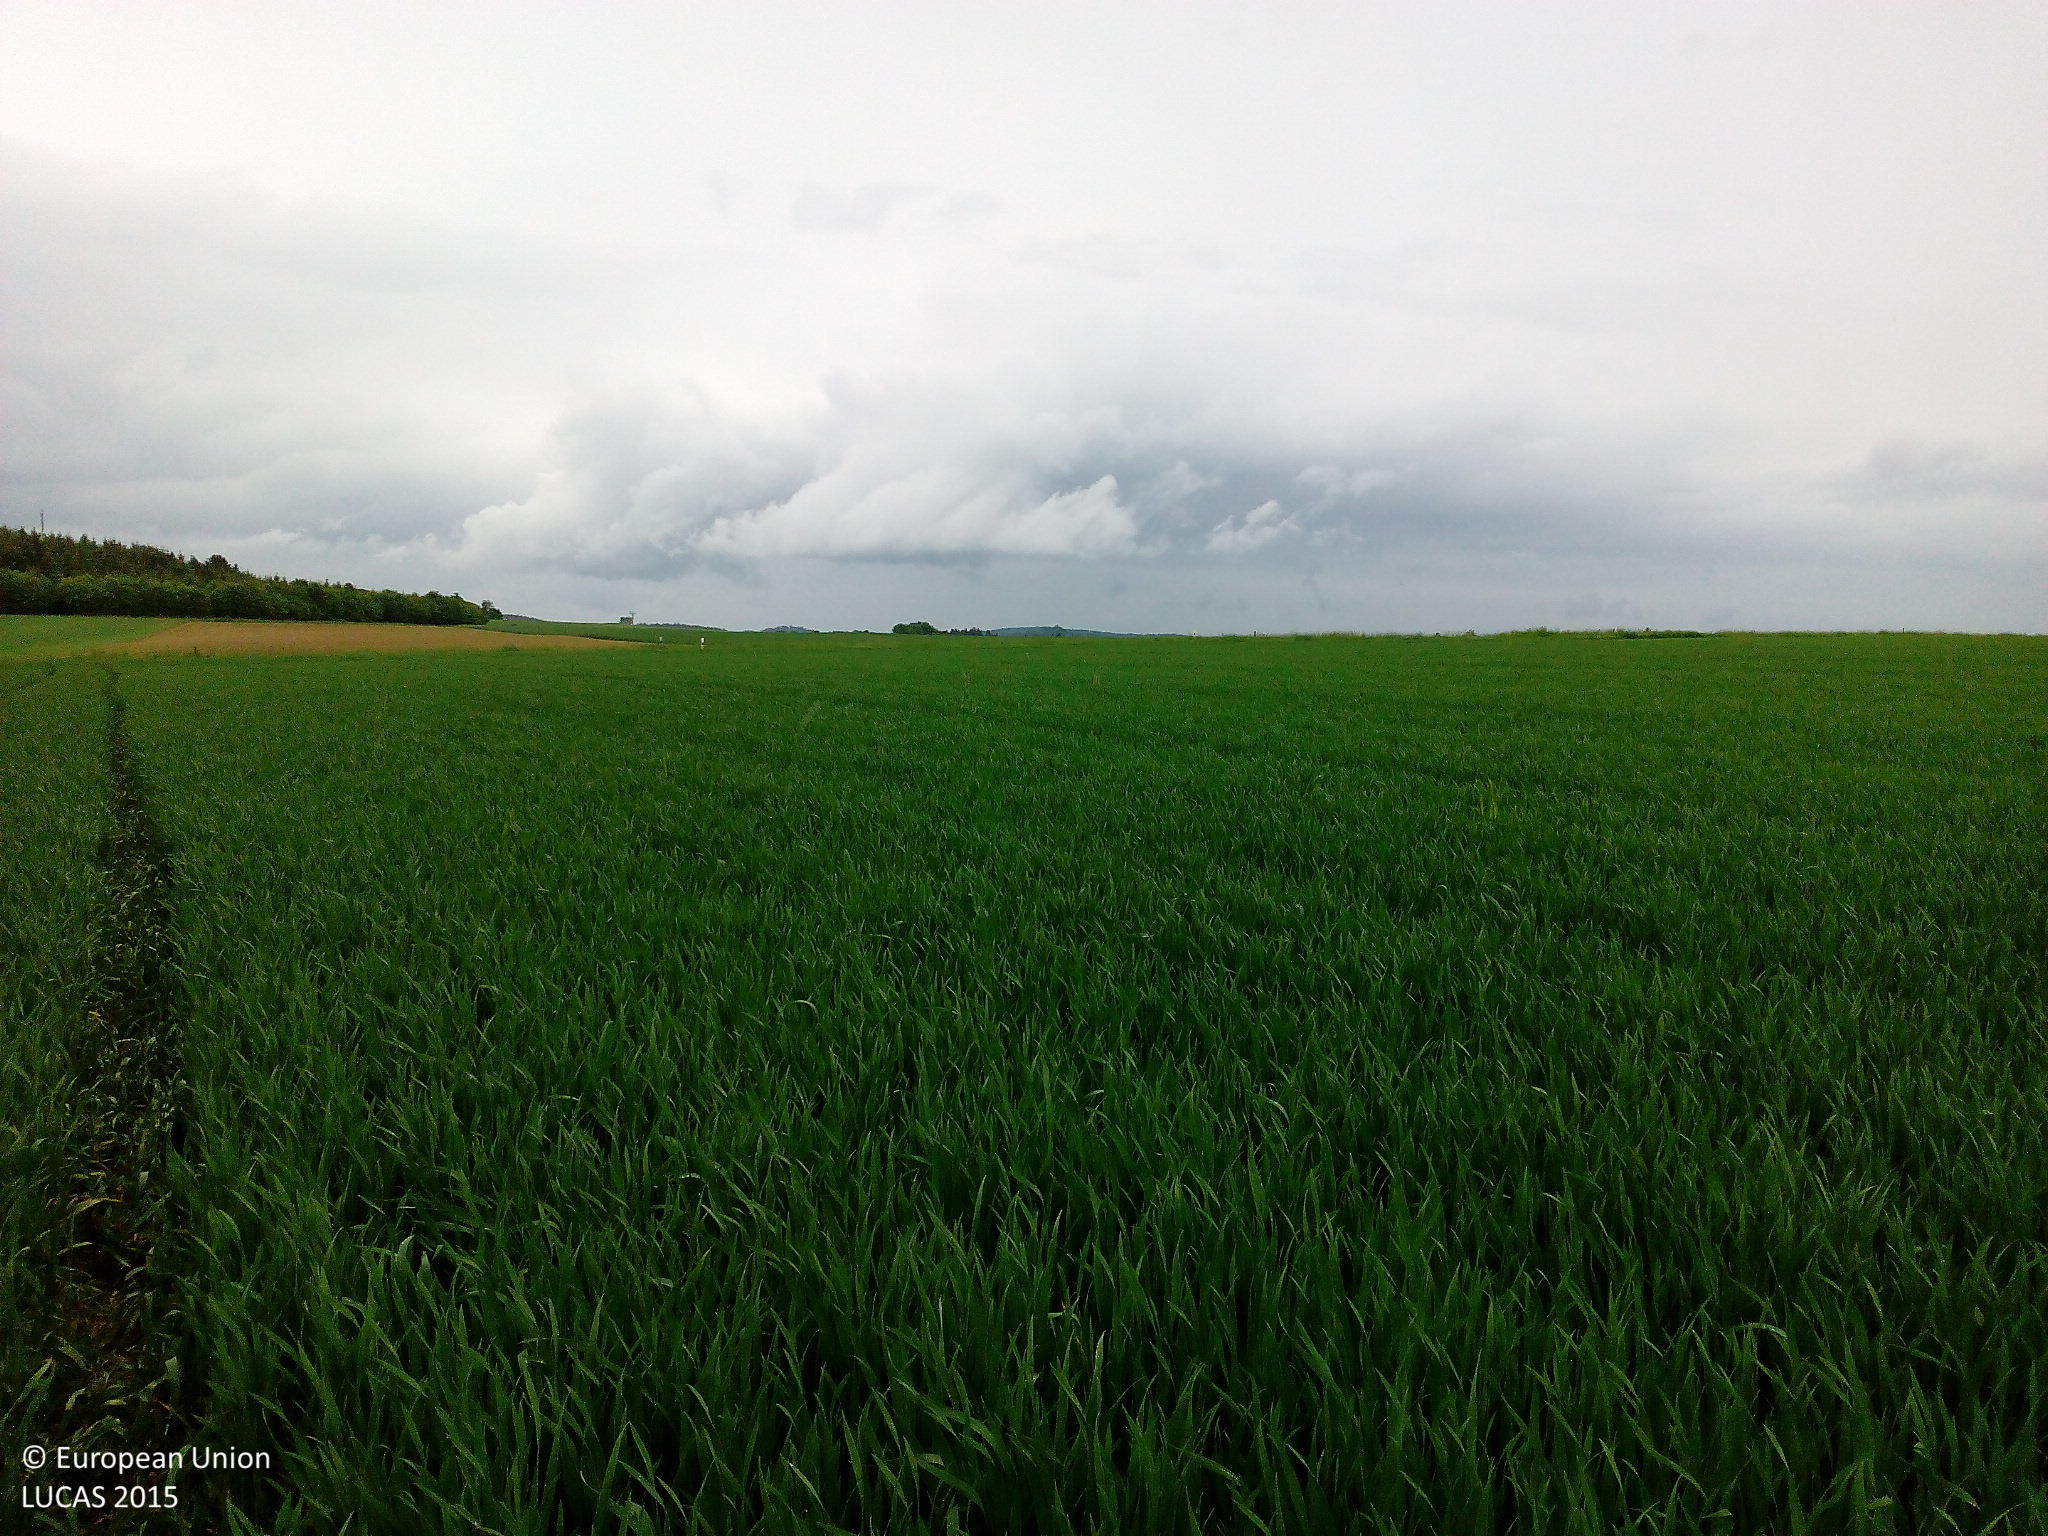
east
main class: Cropland
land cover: Common wheat
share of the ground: > 75 %
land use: Agriculture (excluding fallow land and kitchen gardens)
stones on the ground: < 10 %
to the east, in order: Common wheat; Grass margins; Ditches and canals; Grass margins; Paved roads, cycling and walking lanes; Grass margins; Maize; Barley
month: May
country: DE
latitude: 49.2739
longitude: 11.5801
